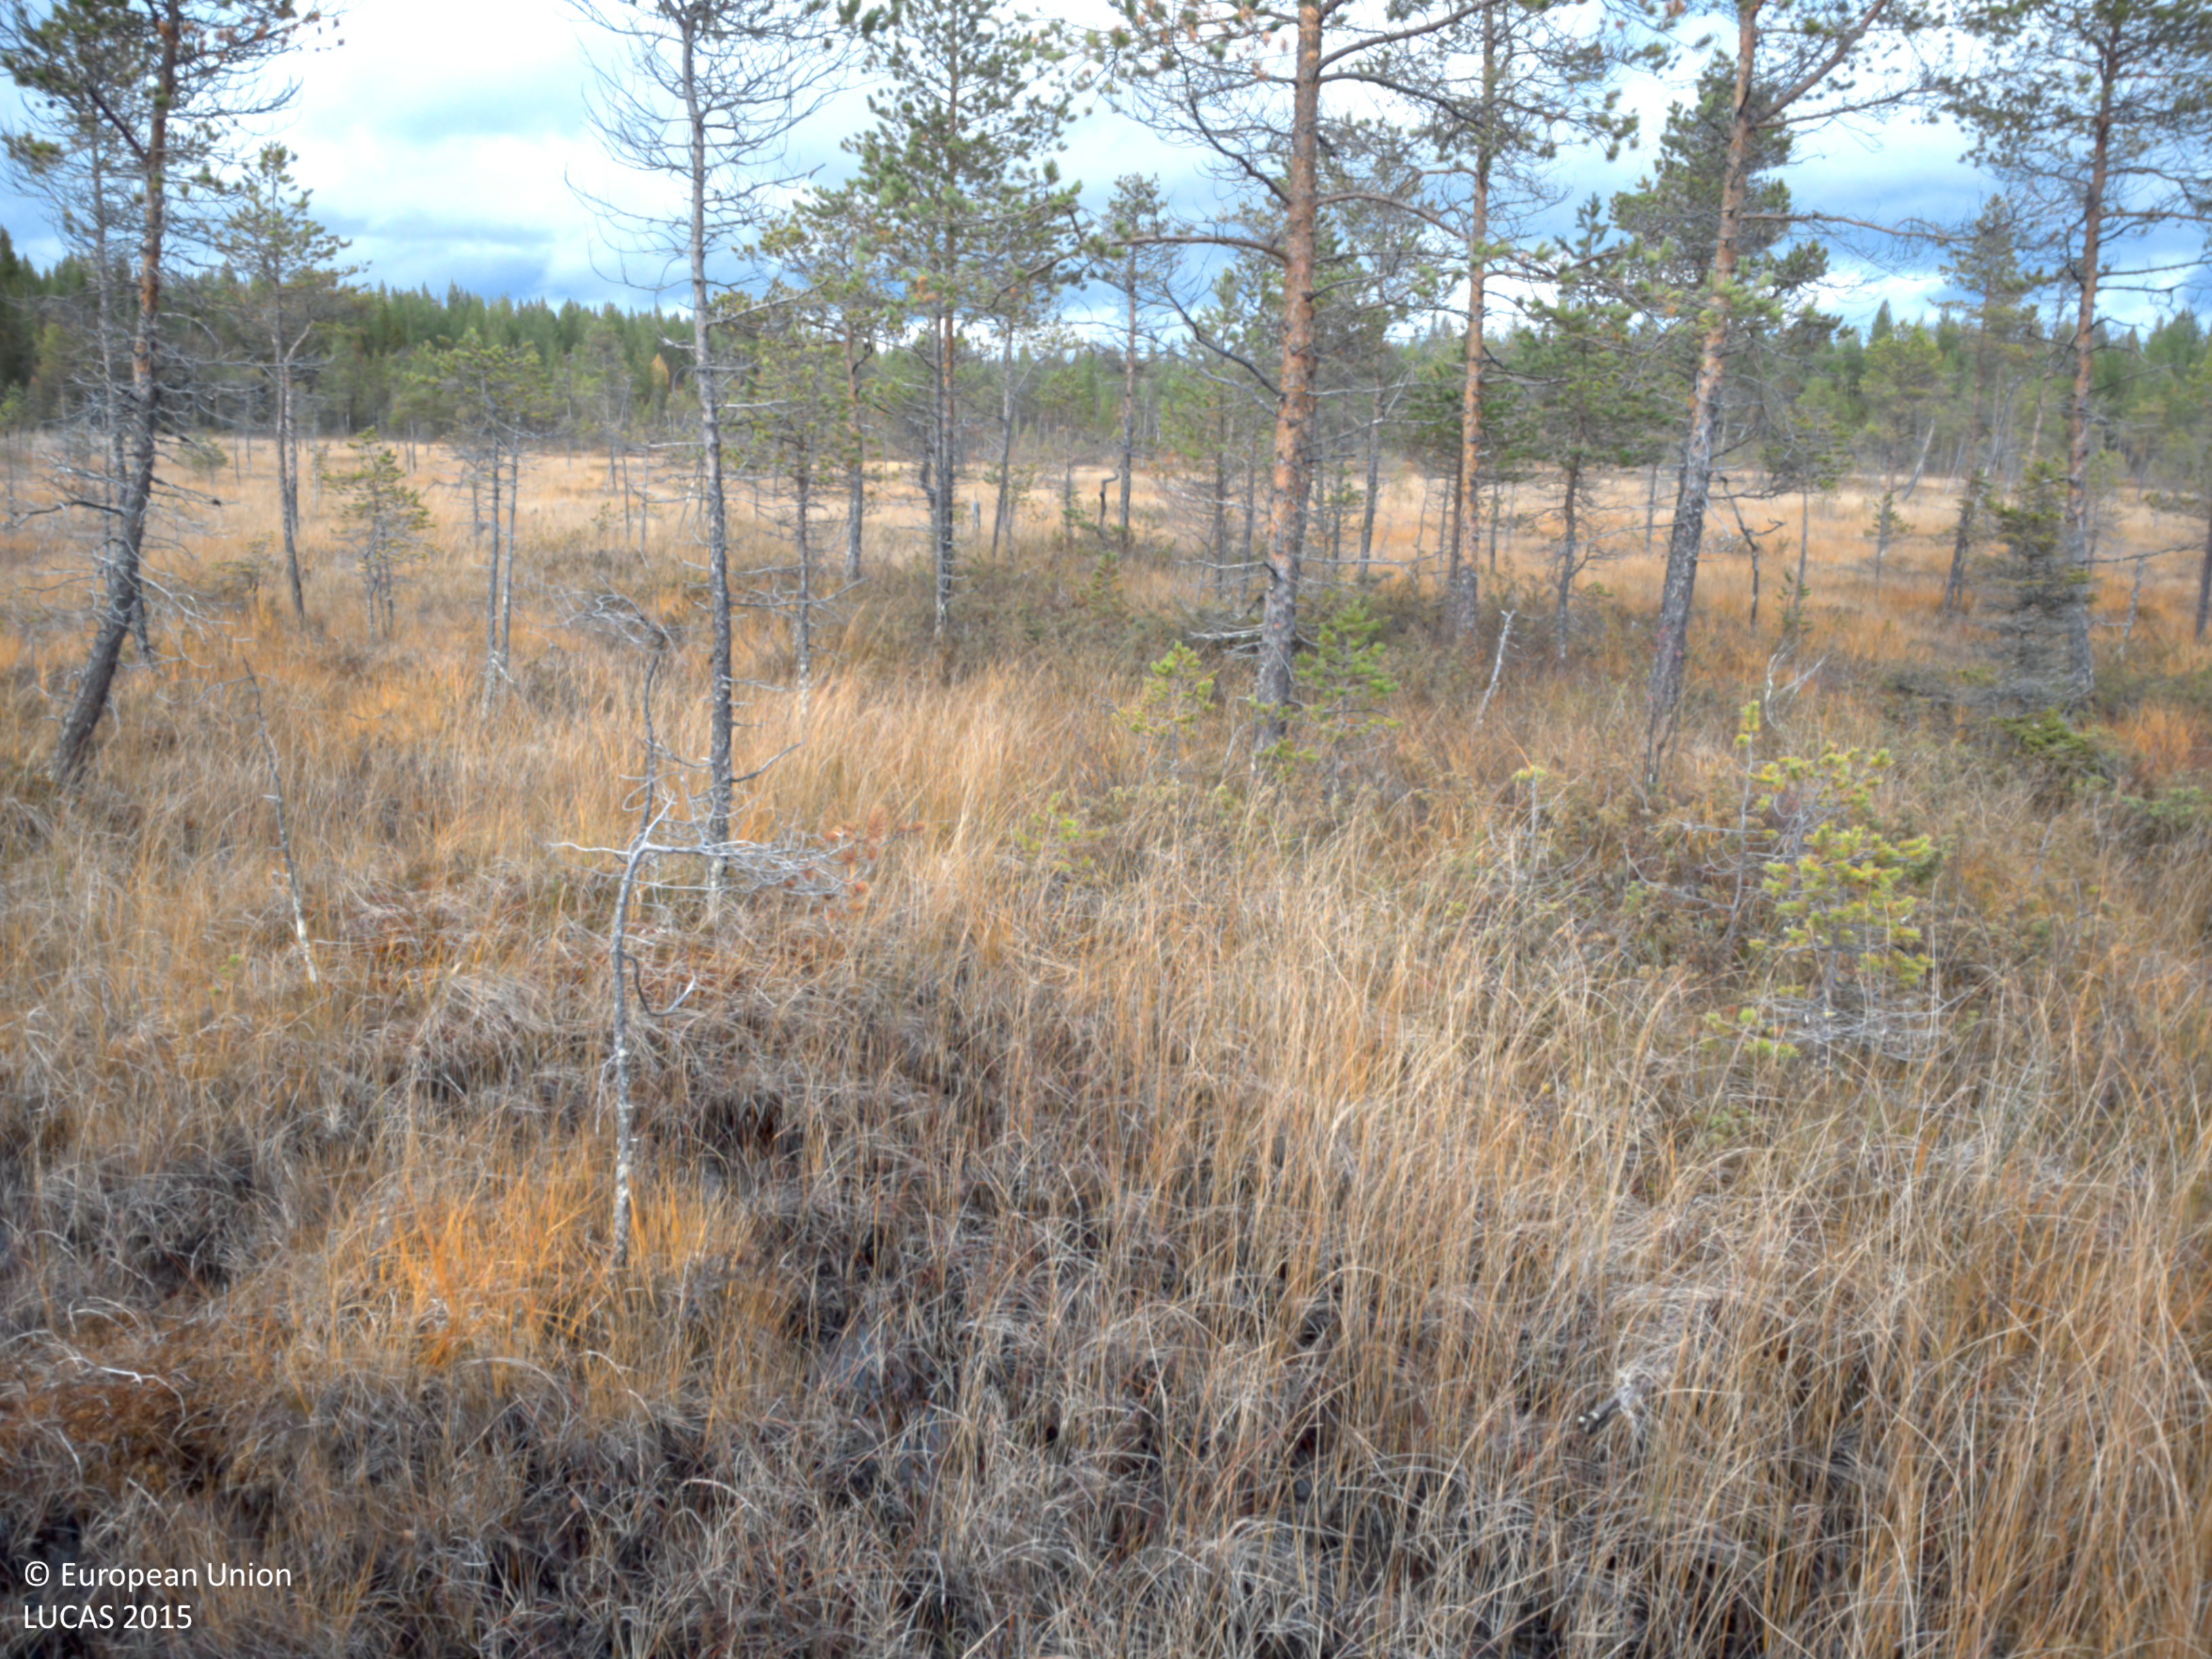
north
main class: Woodland
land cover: Pine dominated coniferous woodland
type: boreal forest
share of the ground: 25 - 50 %
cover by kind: coniferous forest trees 50 %, shrubs 20 %, herbaceous plants 15 %, lichens and mosses 15 %
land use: Semi-natural and natural areas not in use
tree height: < 5 m
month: September
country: SE
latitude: 64.7262
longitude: 18.9733
